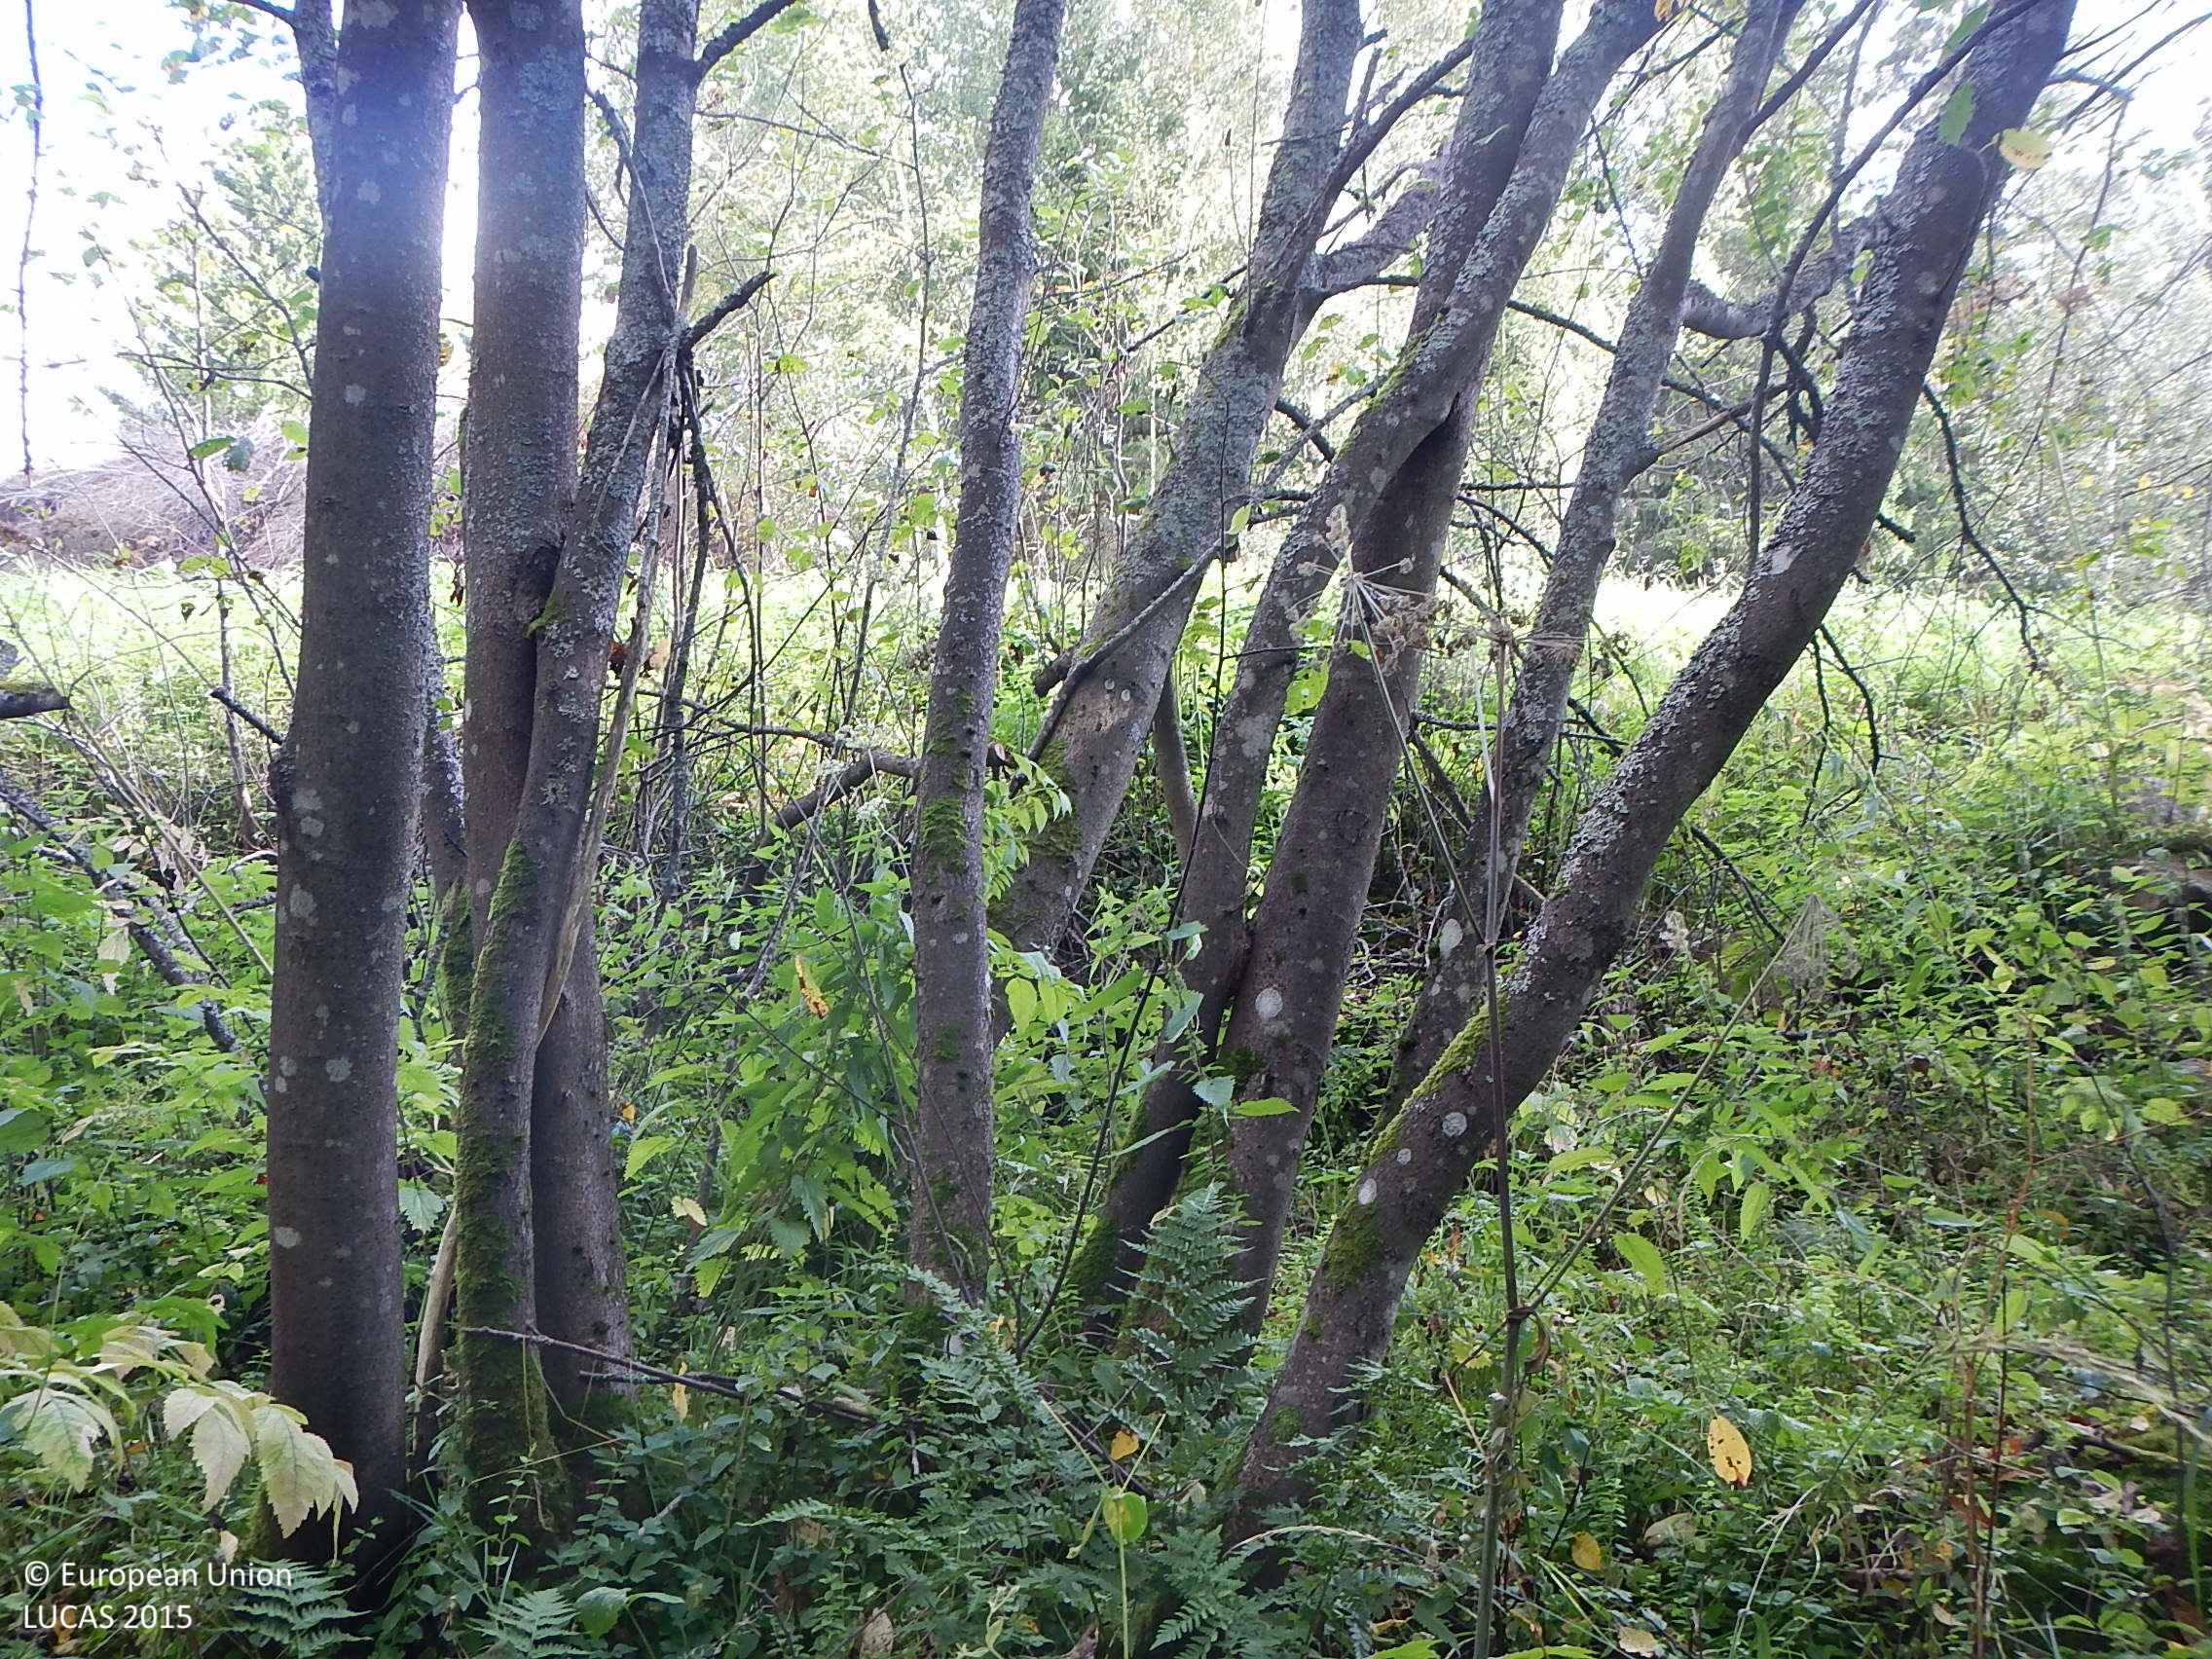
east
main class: Woodland
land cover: Broadleaved woodland
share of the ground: > 75 %
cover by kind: broadleaved forest trees 90 %, shrubs 10 %
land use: Semi-natural and natural areas not in use
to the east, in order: Rivers and streams; Broadleaved woodland; Grassland without tree/shrub cover; Artificial constructions in urban areas; Spruce dominated mixed woodland; Ditches and canals; Spruce dominated mixed woodland; Spontaneously vegetated surfaces; Other mixed woodland
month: September
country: FI
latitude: 61.4541
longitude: 22.0065
